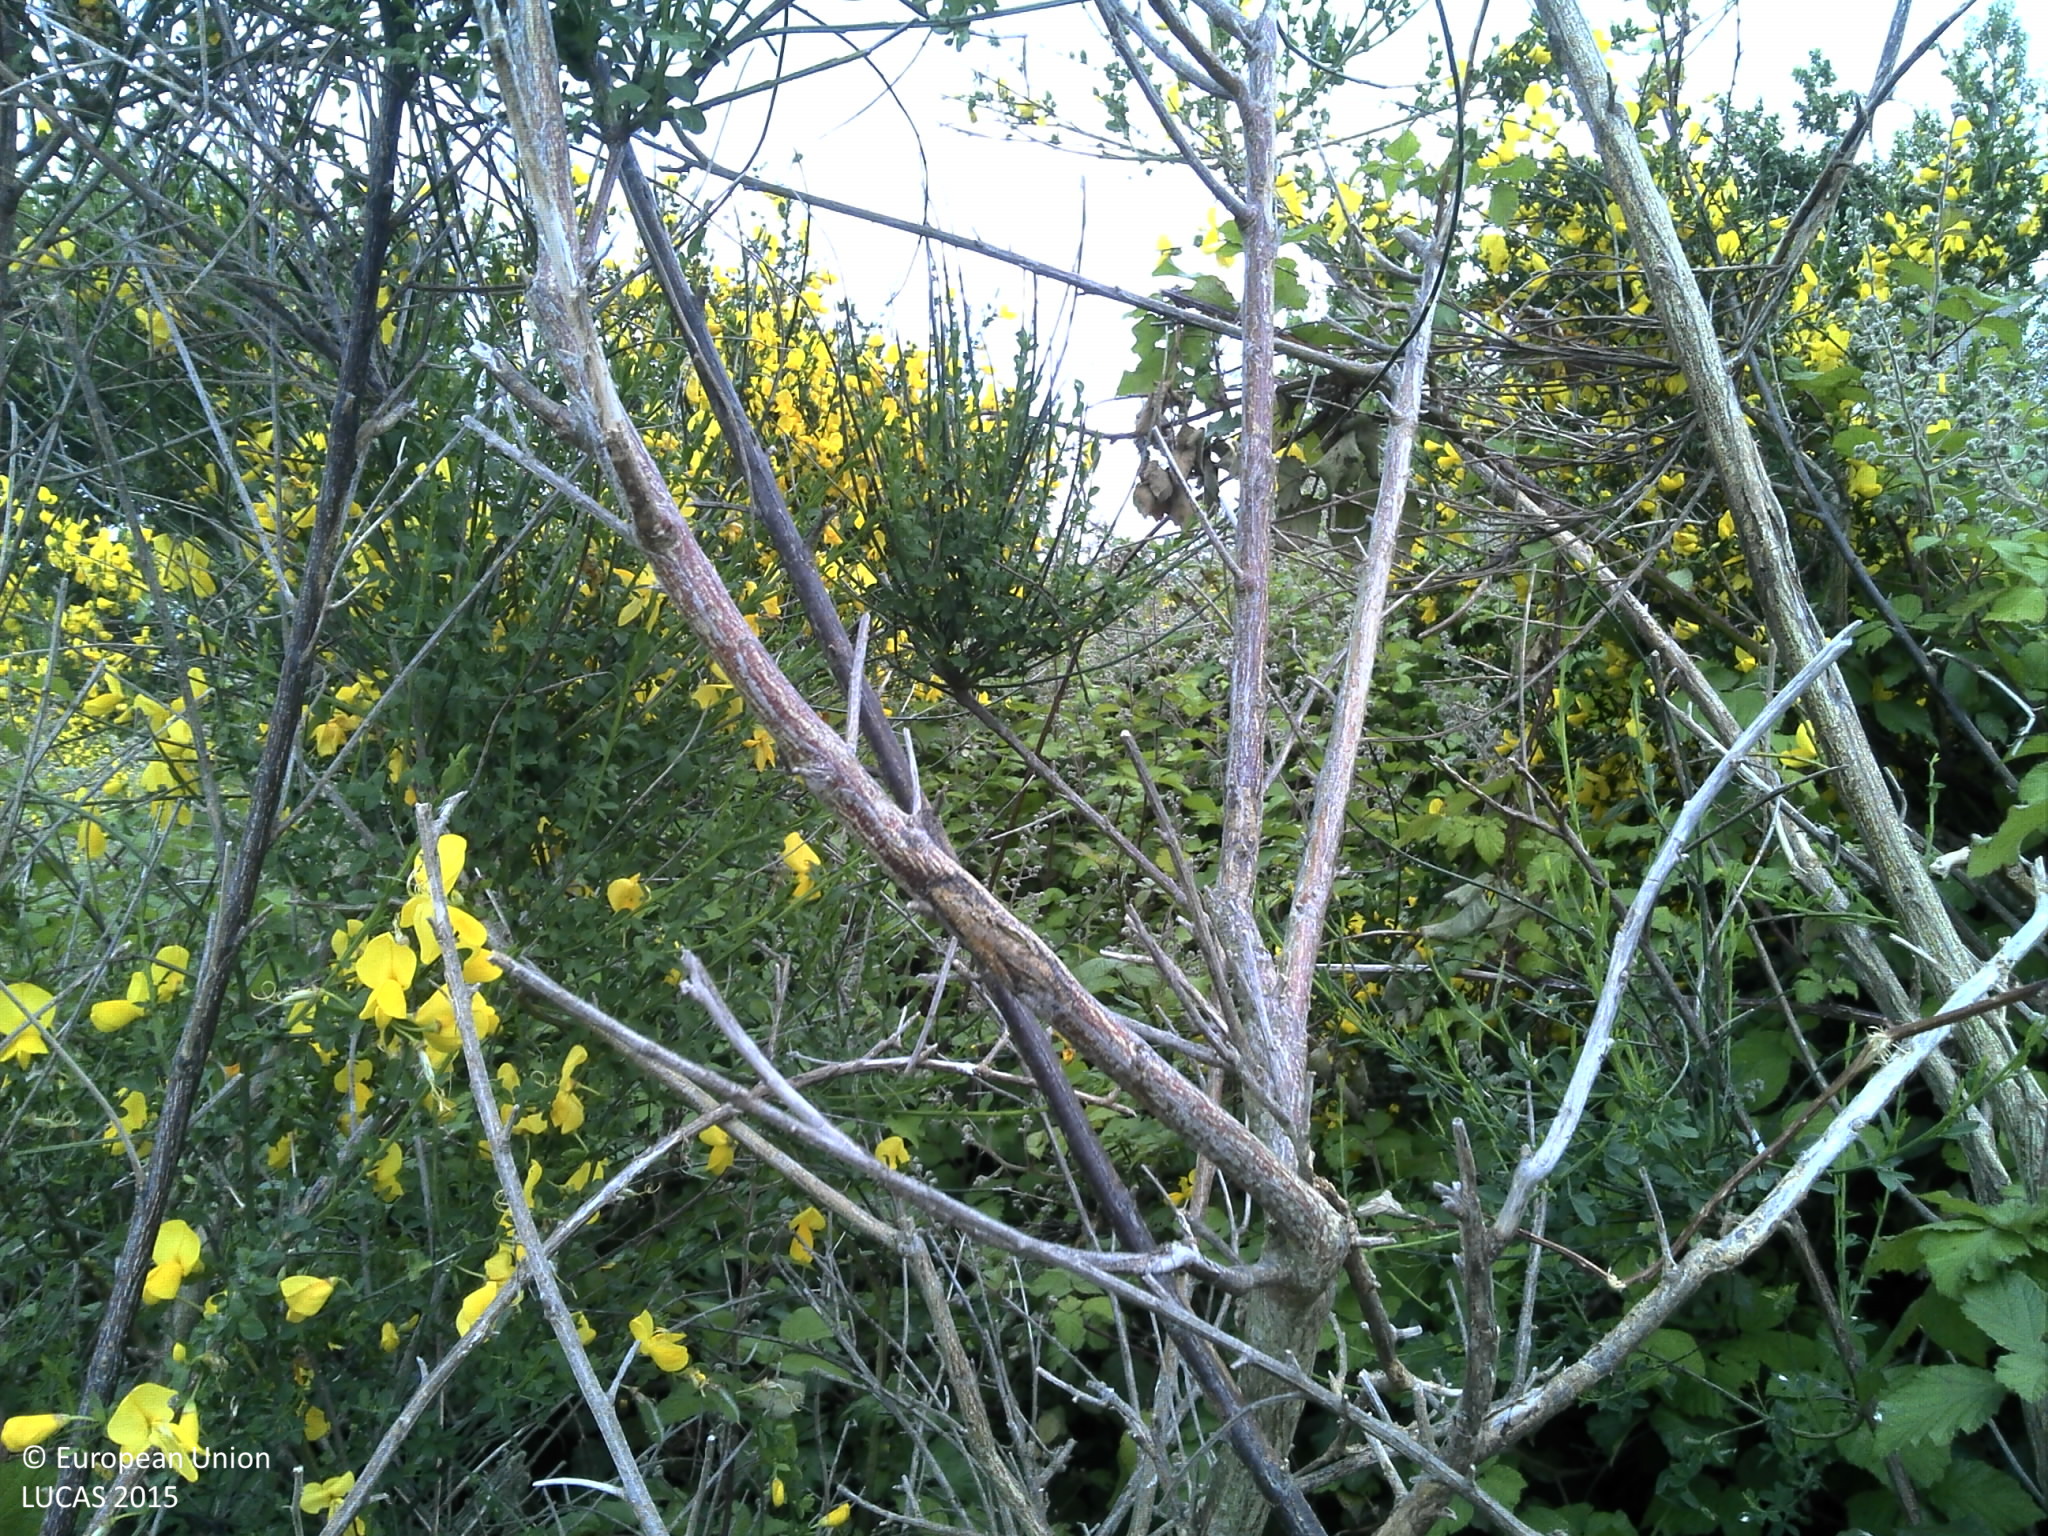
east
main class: Shrubland
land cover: Shrubland without tree cover
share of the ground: > 75 %
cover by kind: shrubs 90 %, herbaceous plants 5 %, unconsolidated bare surface 5 %
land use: Abandoned areas
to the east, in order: Shrubland without tree cover; Shrubland with sparse tree cover; Shrubland without tree cover; Arable land (only in case pi); Shrubland with sparse tree cover; Shrubland without tree cover; Shrubland with sparse tree cover; Broadleaved woodland
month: May
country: PT
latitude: 41.0937
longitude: -7.9308
